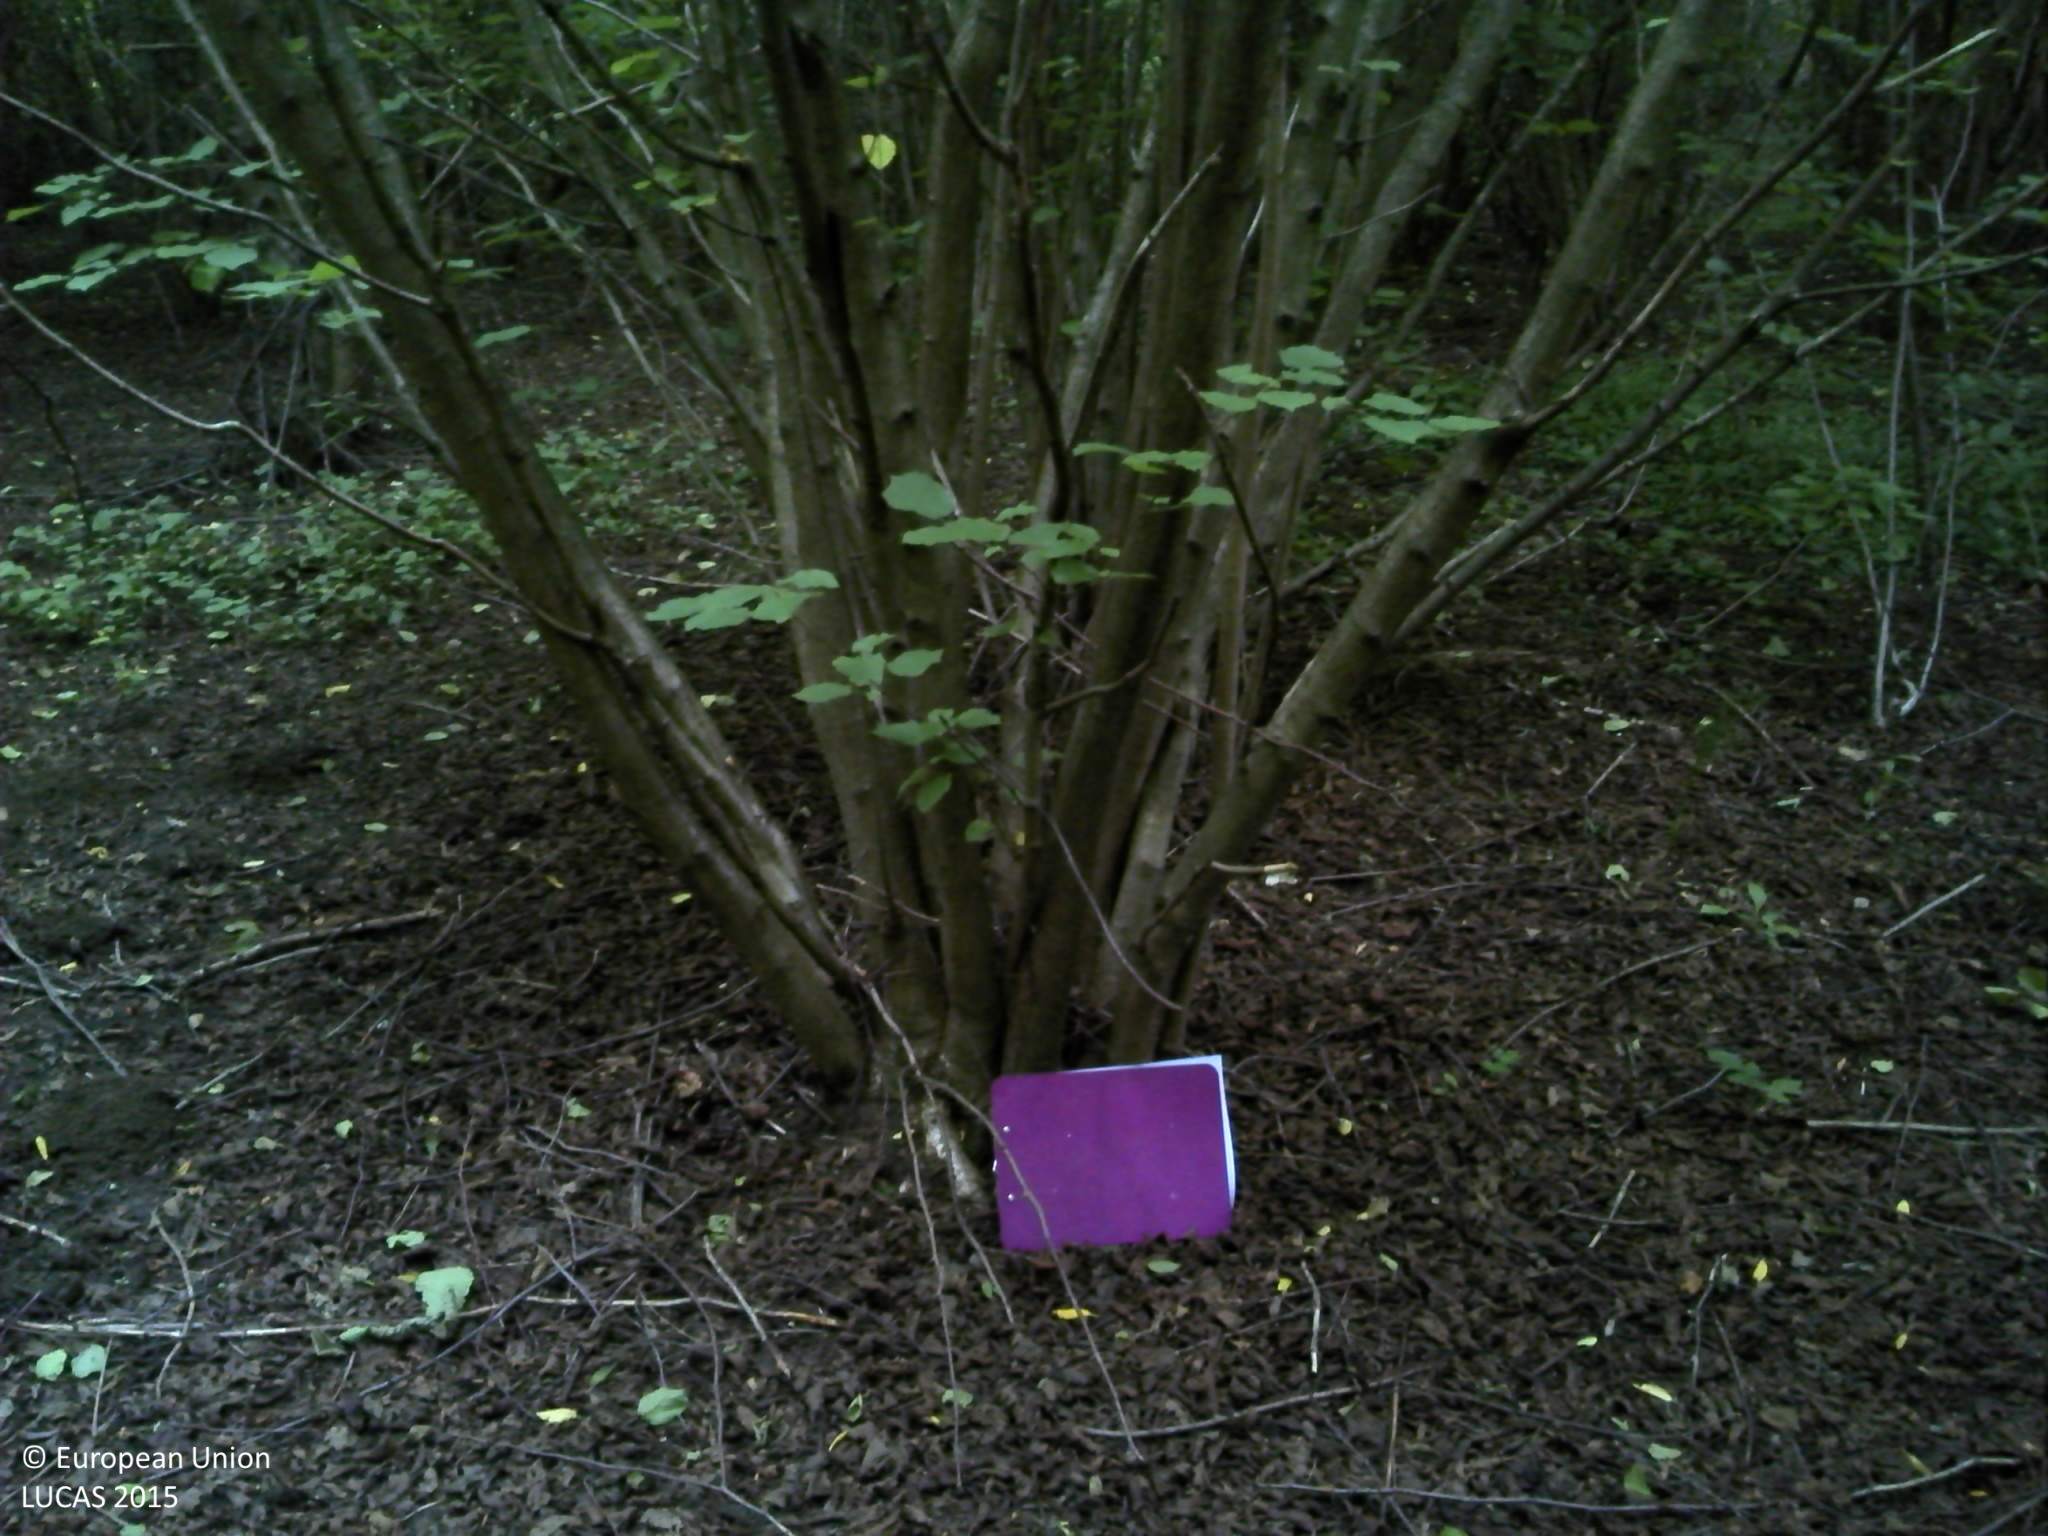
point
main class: Woodland
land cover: Broadleaved woodland
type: acidophilous oak and oak-birch forest
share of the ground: > 75 %
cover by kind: broadleaved forest trees 100 %
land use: Forestry
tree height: > 5 m
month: June
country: HR
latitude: 45.3122
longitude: 17.2065
